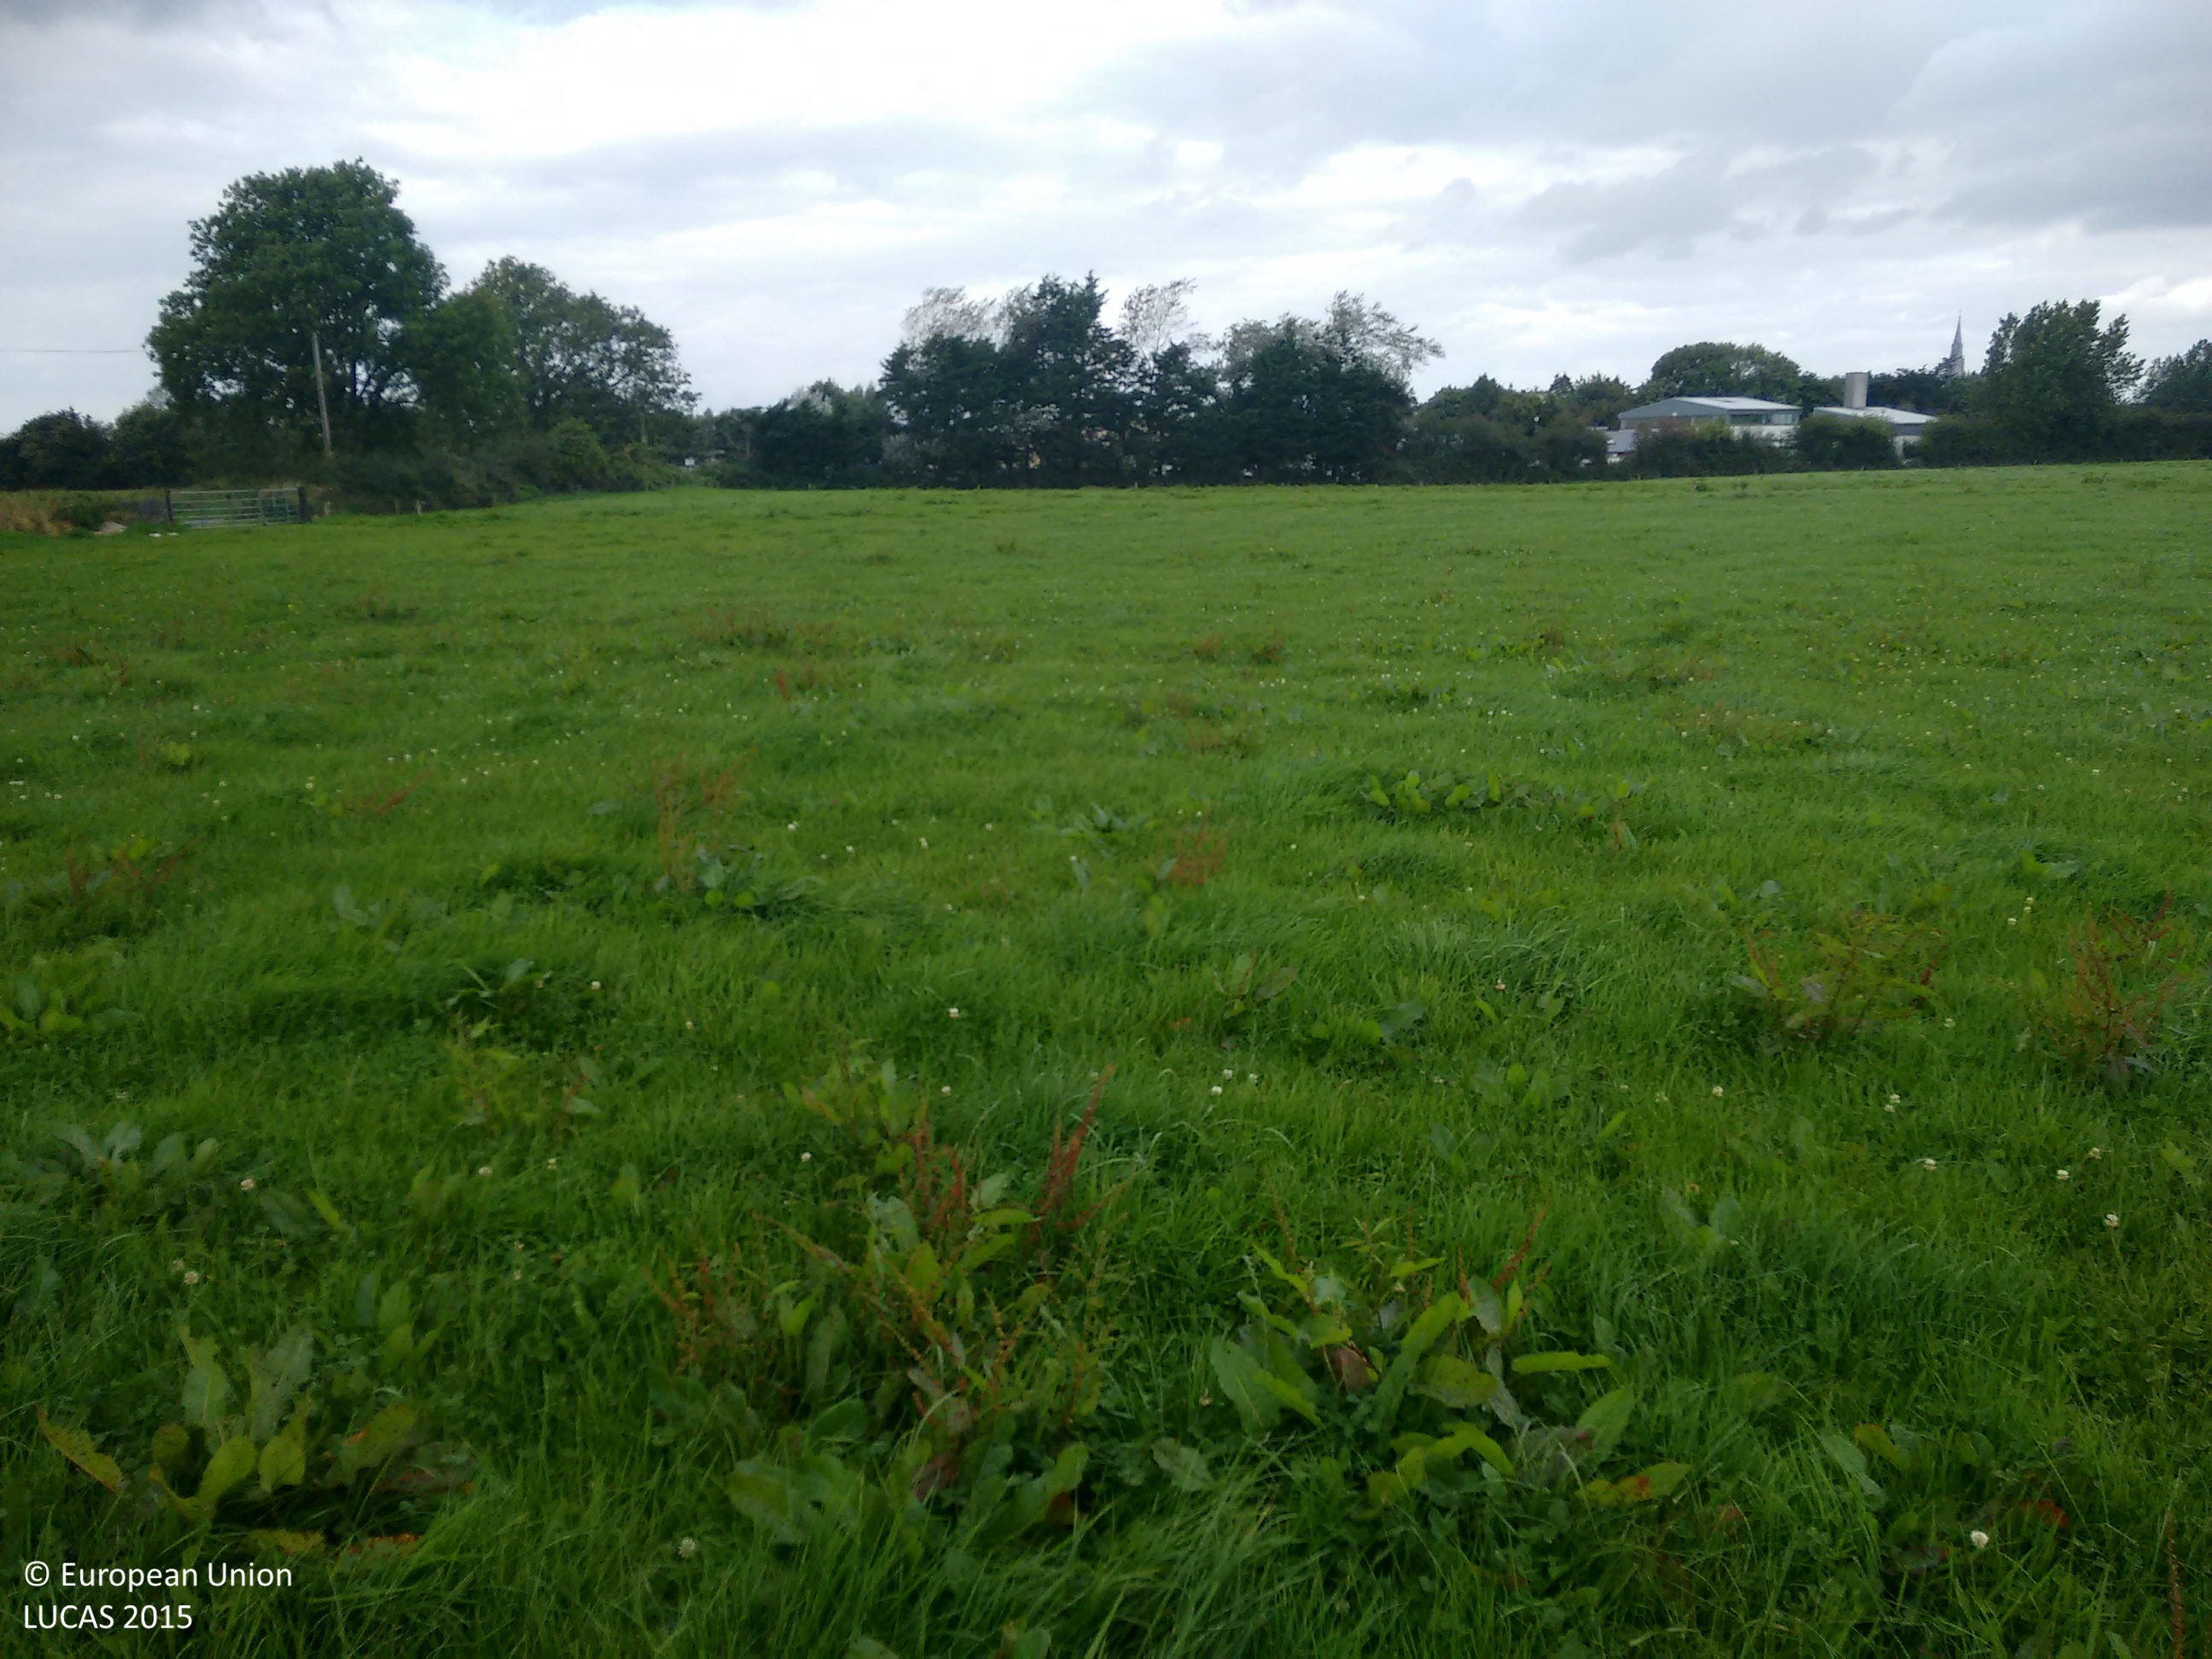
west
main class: Grassland
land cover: Grassland without tree/shrub cover
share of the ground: > 75 %
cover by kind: herbaceous plants 100 %
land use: Agriculture (excluding fallow land and kitchen gardens)
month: September
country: IE
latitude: 52.2267
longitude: -9.4535
